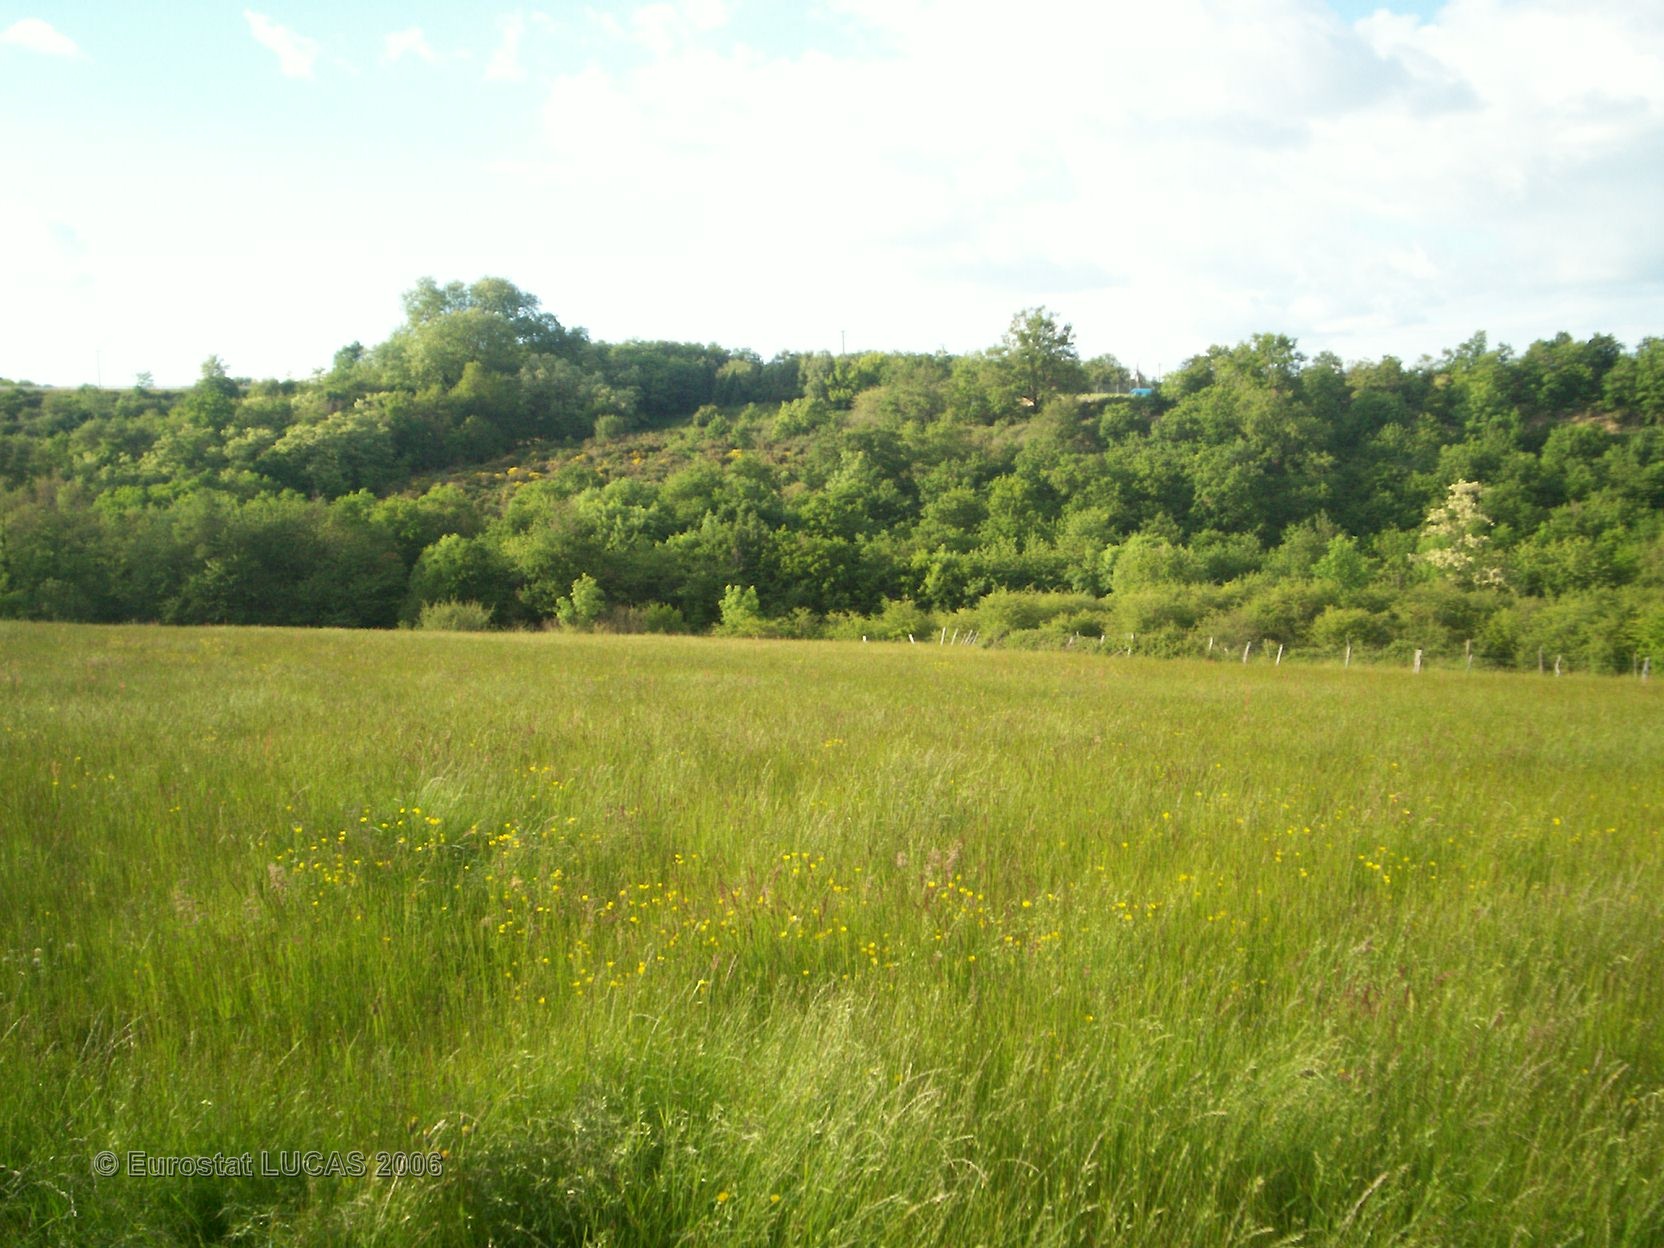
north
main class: Grassland
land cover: Grassland without tree/shrub cover
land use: Agriculture (excluding fallow land and kitchen gardens)
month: June
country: FR
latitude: 46.0958
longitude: 3.1564
